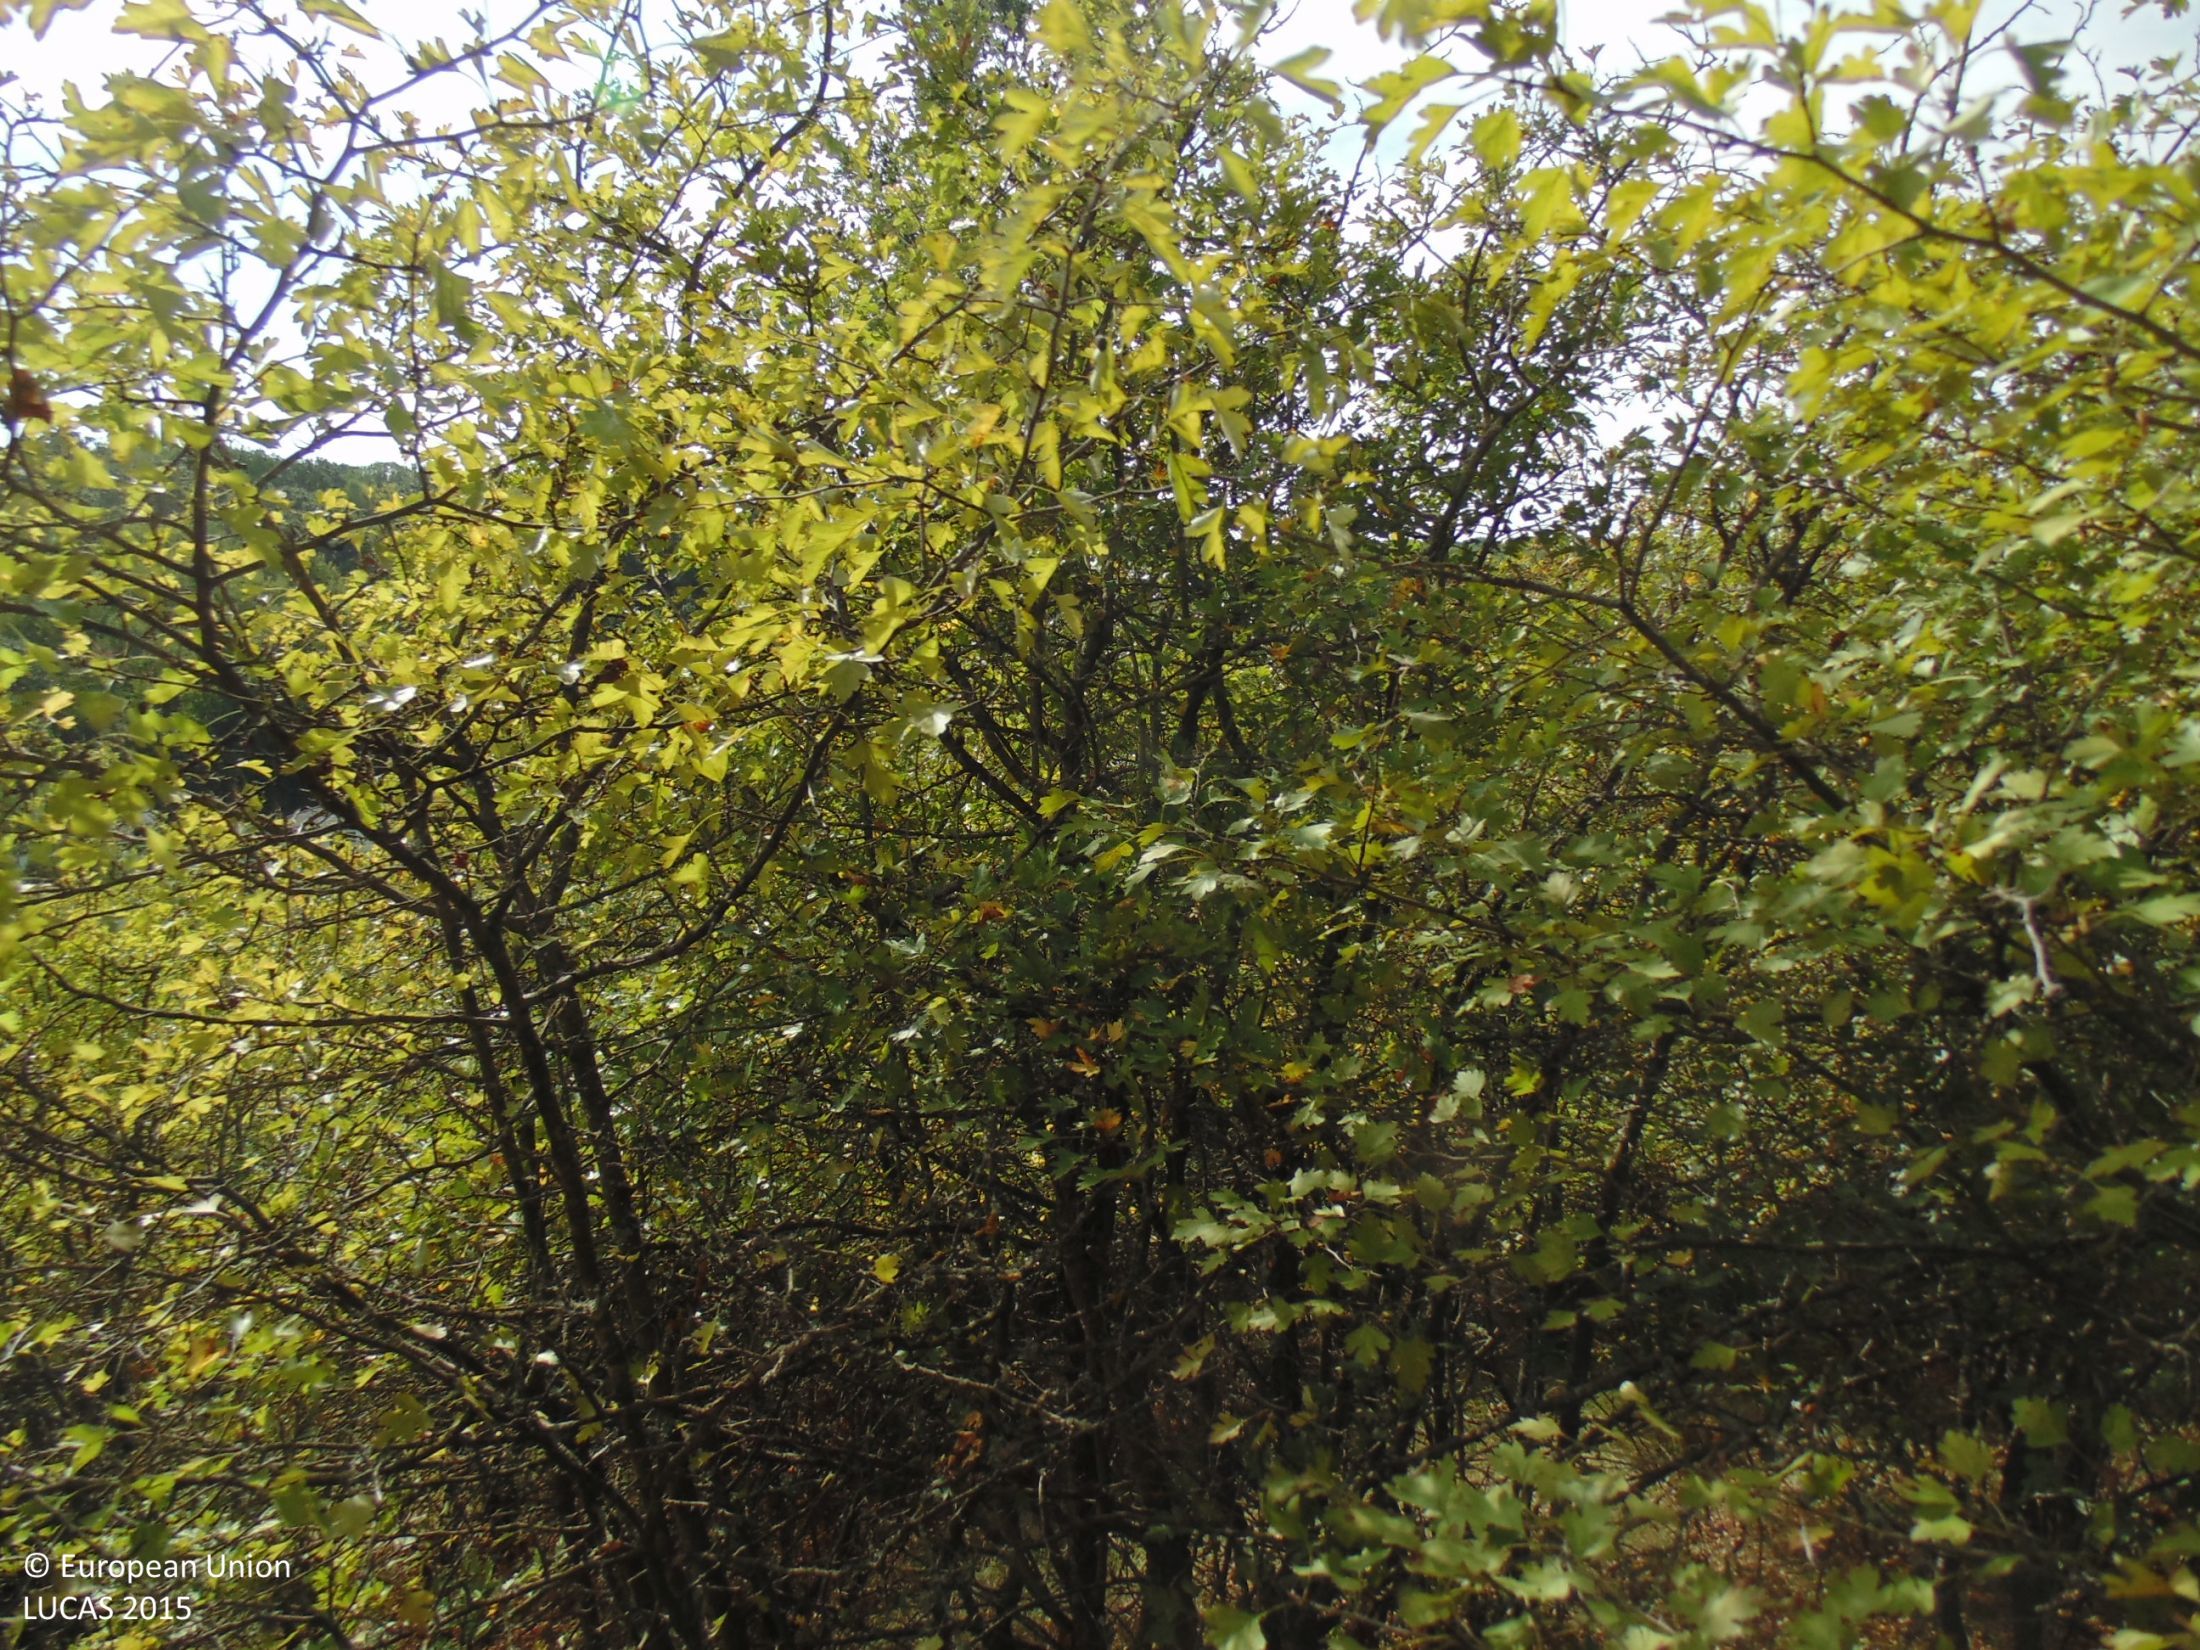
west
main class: Shrubland
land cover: Shrubland with sparse tree cover
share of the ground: 50 - 75 %
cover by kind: shrubs 65 %, herbaceous plants 30 %, broadleaved forest trees 5 %
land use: Semi-natural and natural areas not in use
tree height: < 5 m
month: September
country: BG
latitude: 43.9609
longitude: 27.1382
